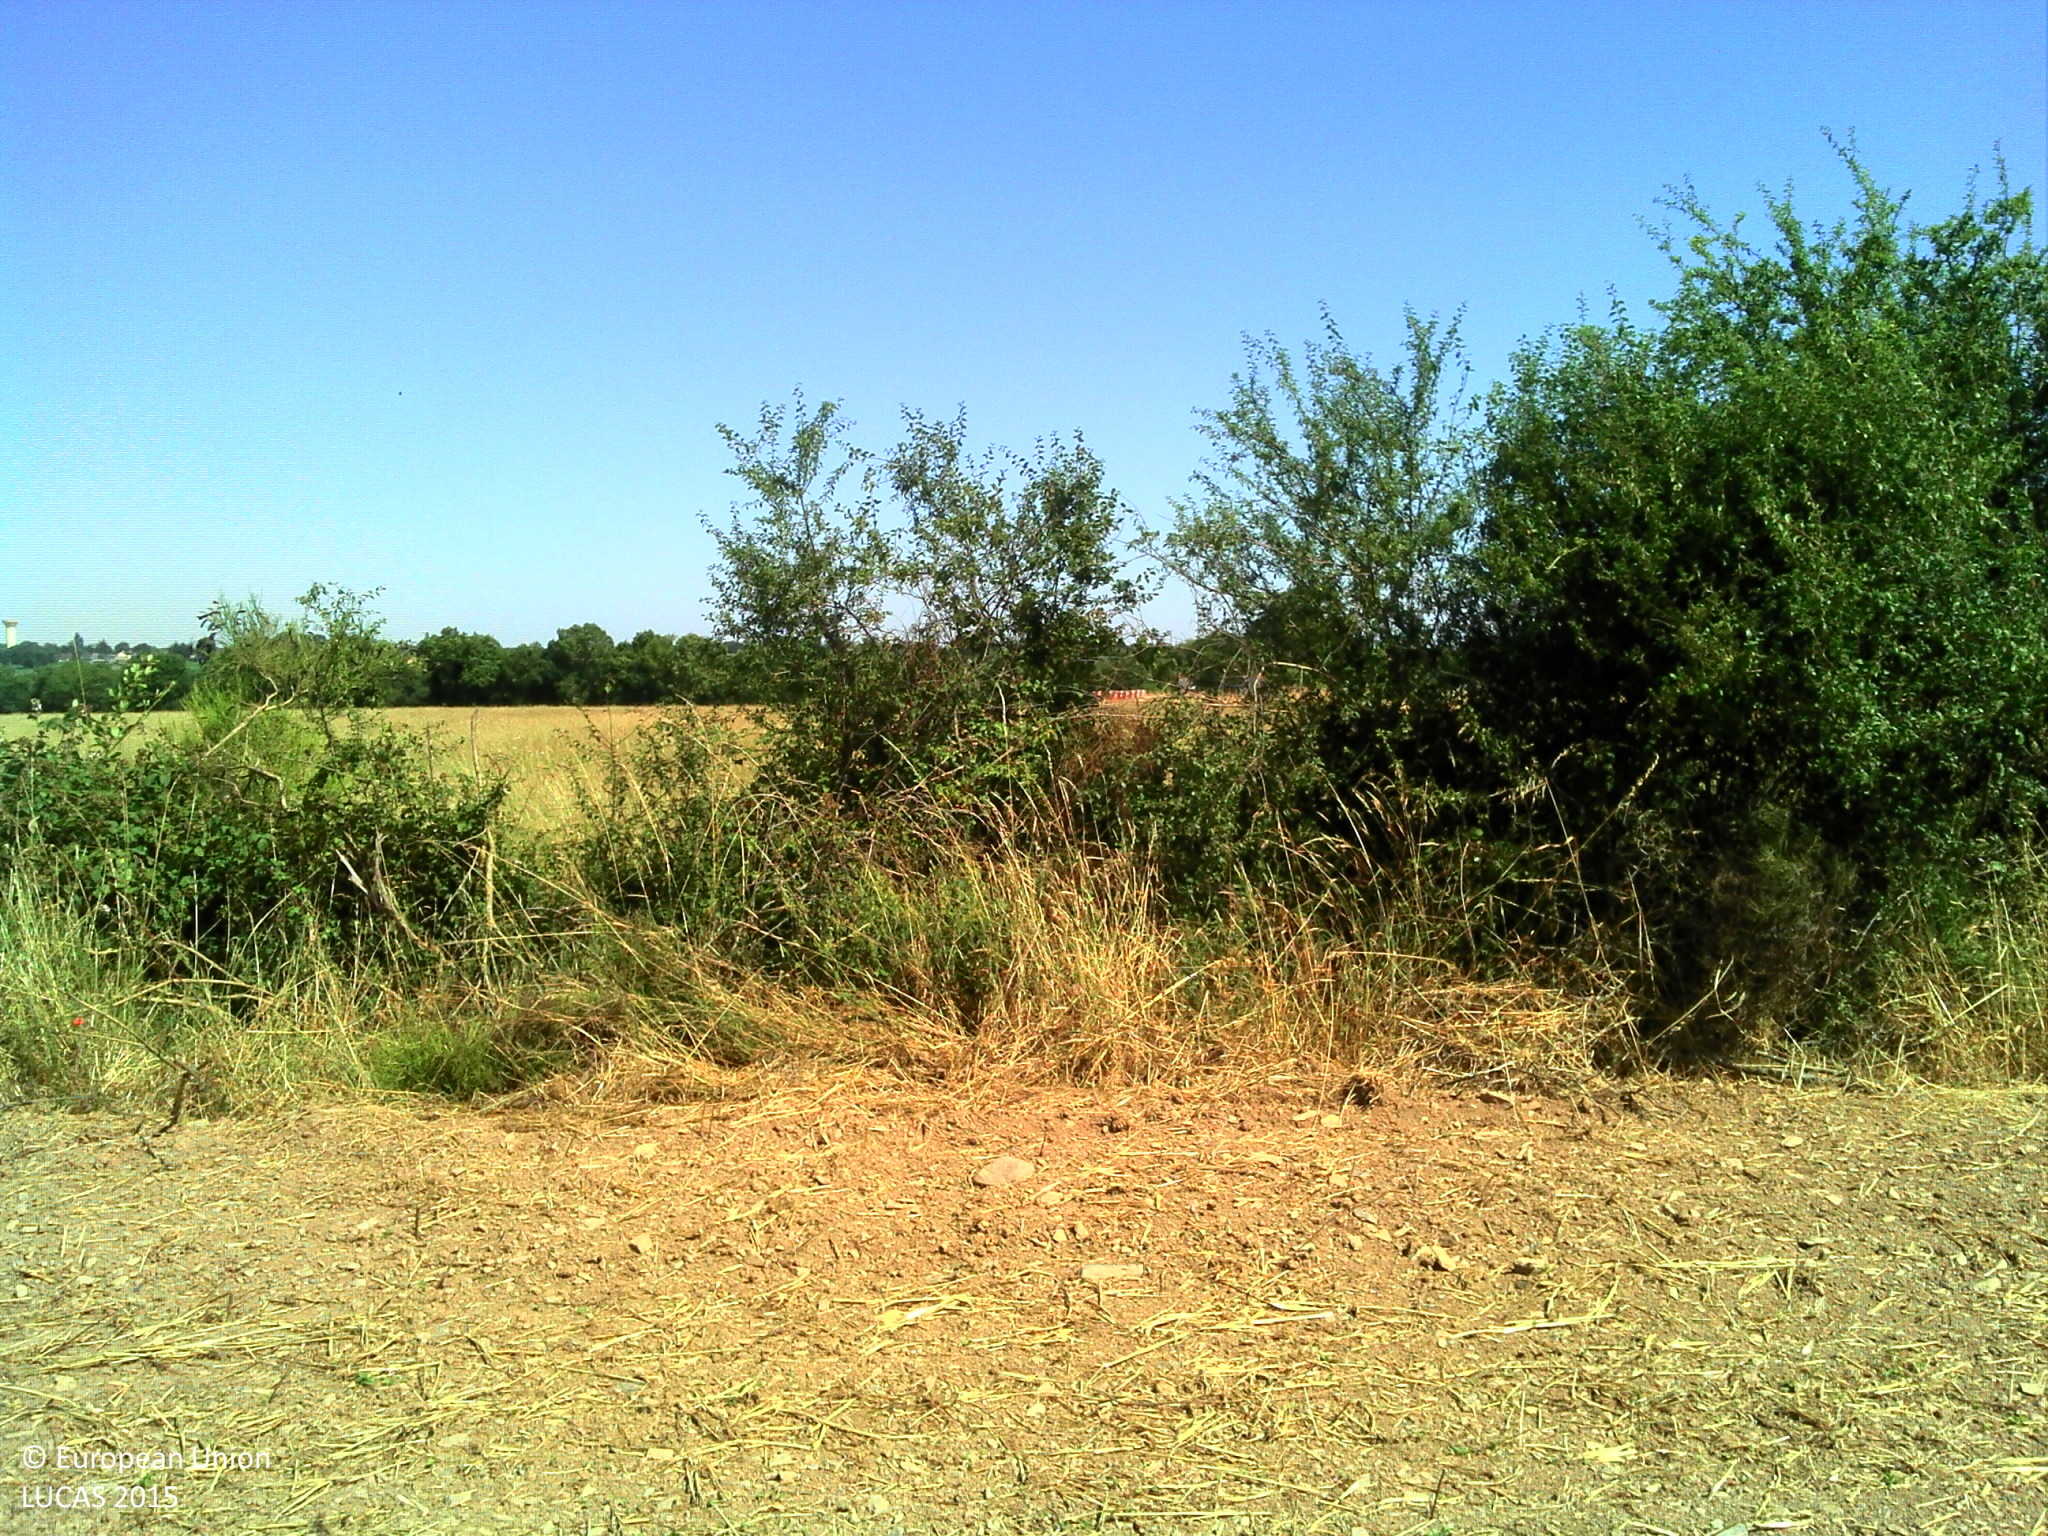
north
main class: Cropland
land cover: Barley
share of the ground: < 10 %
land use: Agriculture (excluding fallow land and kitchen gardens)
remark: Tilled/Sowed
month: July
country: FR
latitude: 47.7246
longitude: -1.8744
